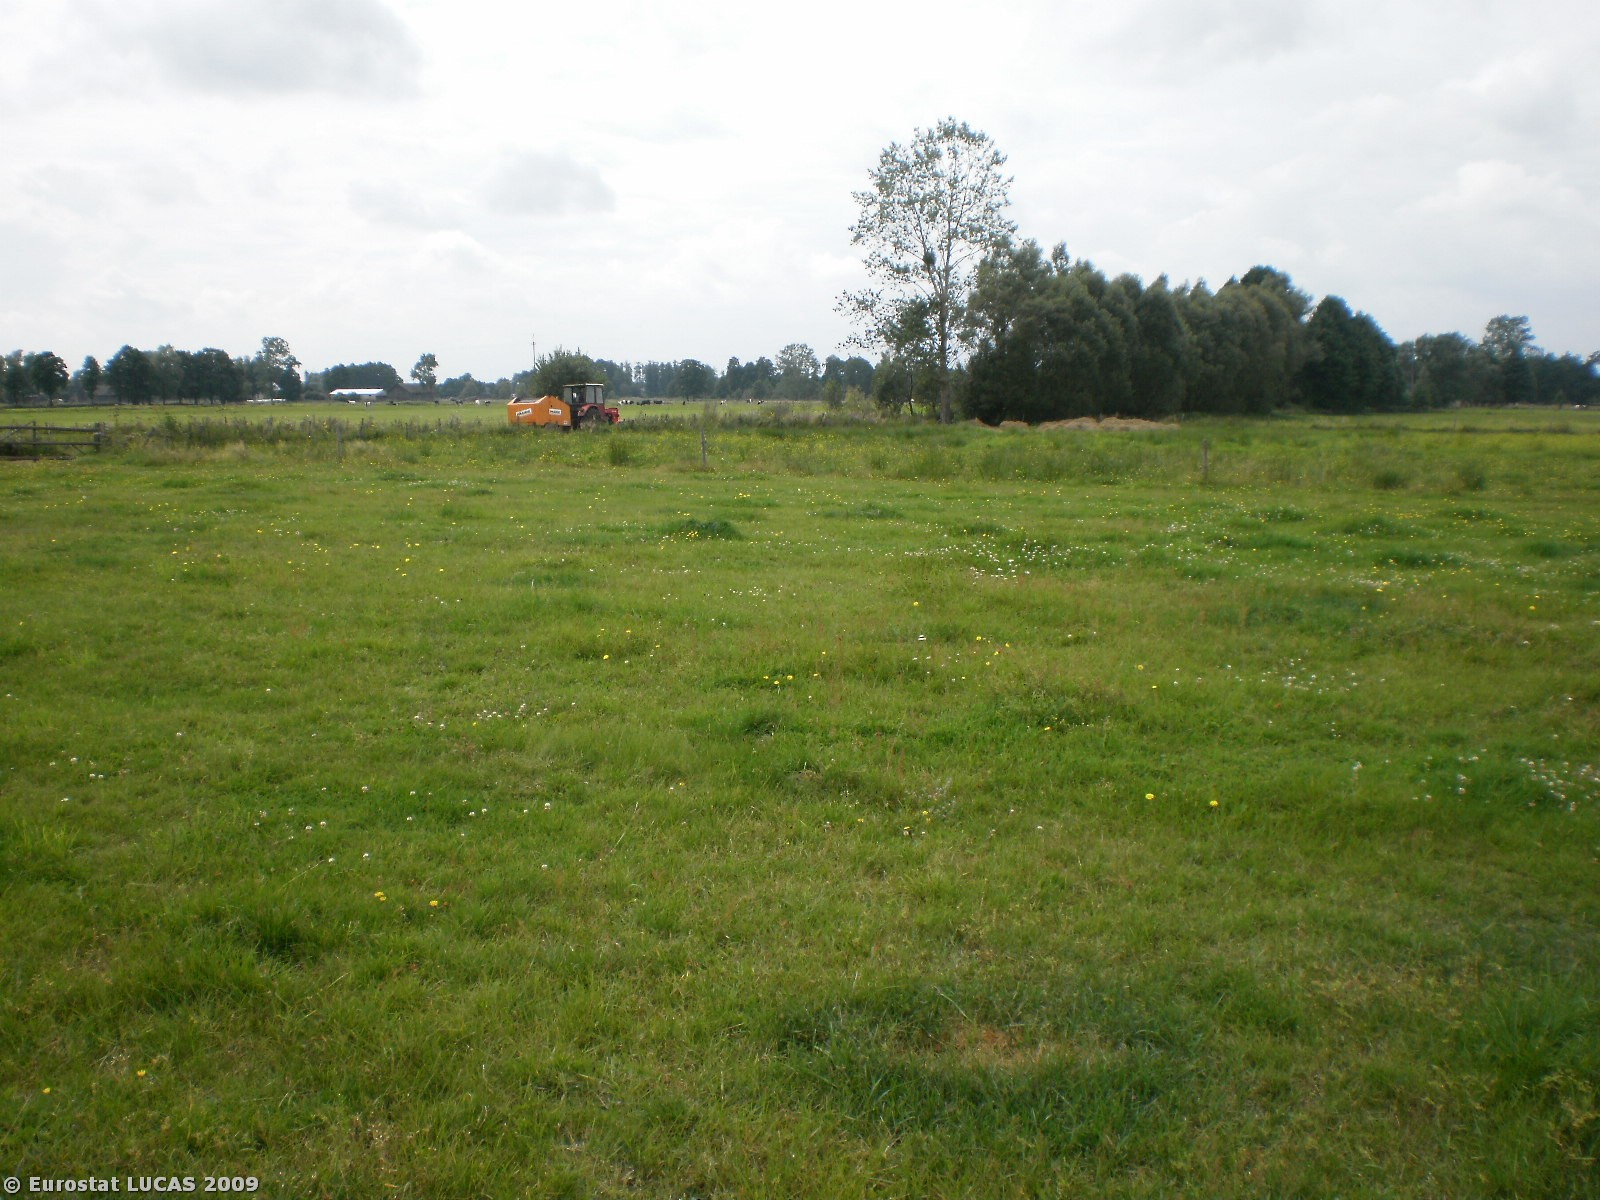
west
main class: Grassland
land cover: Grassland without tree/shrub cover
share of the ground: > 75 %
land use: Agriculture (excluding fallow land and kitchen gardens)
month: August
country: PL
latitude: 53.2469
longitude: 20.9682
